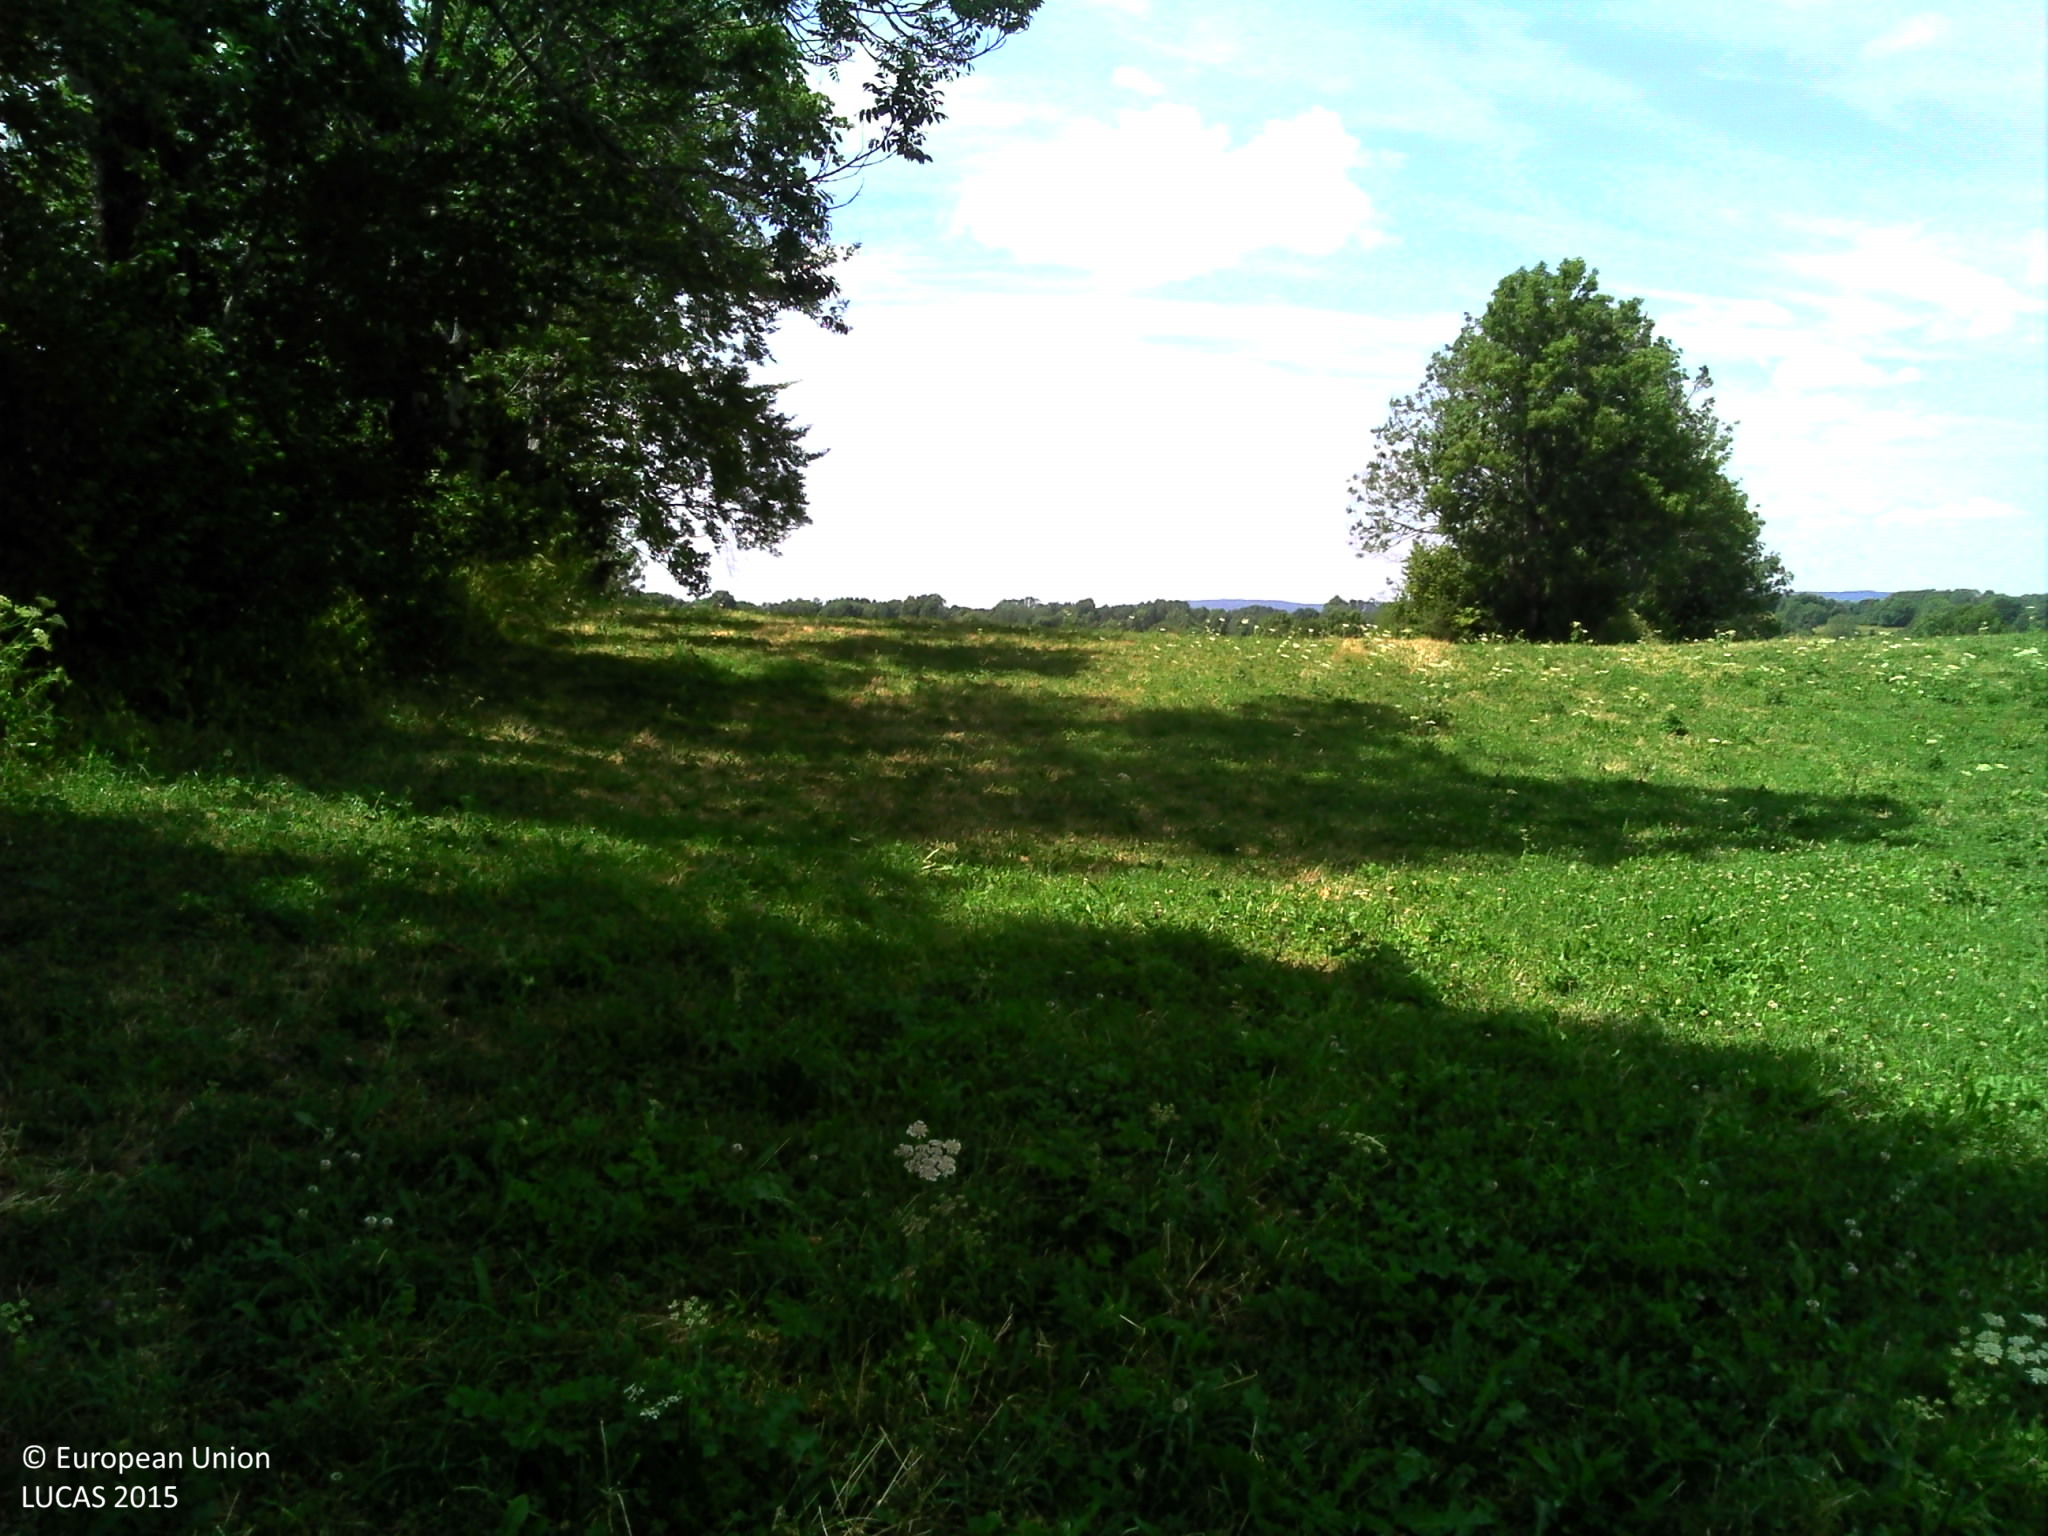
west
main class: Grassland
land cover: Grassland without tree/shrub cover
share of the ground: > 75 %
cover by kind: herbaceous plants 100 %
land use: Agriculture (excluding fallow land and kitchen gardens)
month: July
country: FR
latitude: 46.7305
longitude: 6.0900
